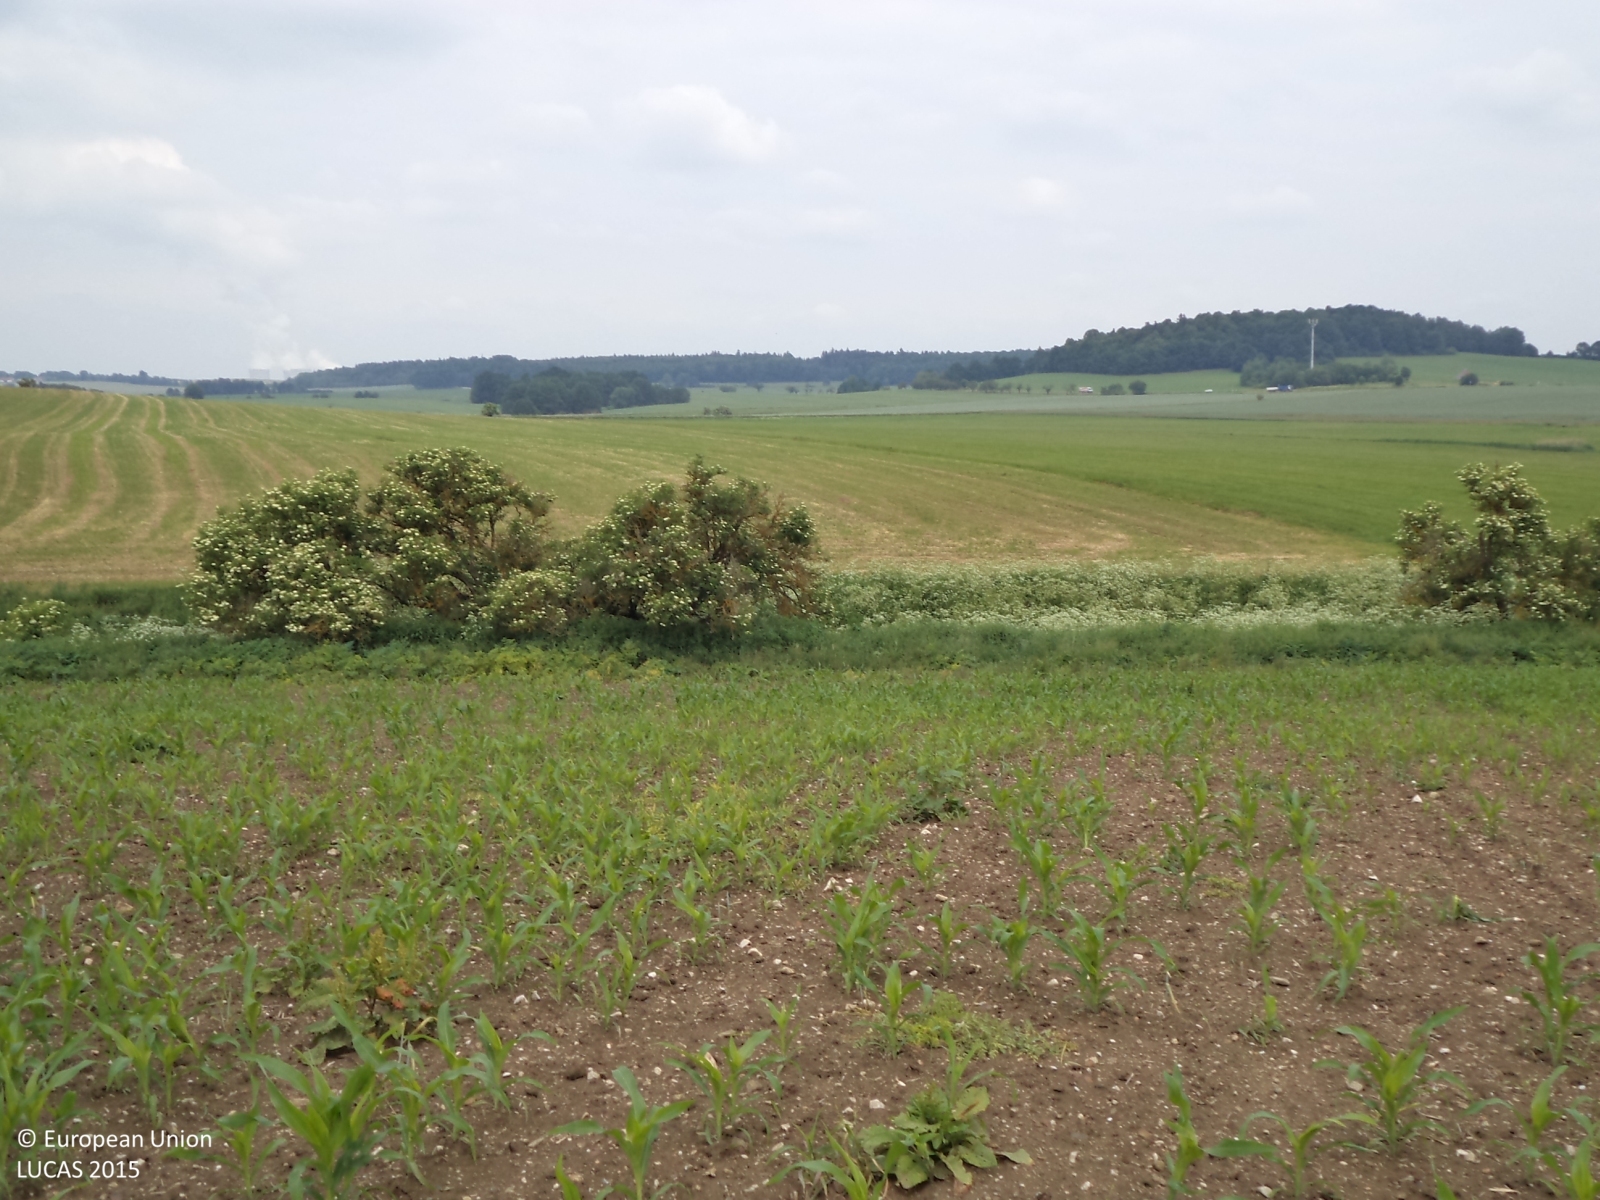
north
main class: Cropland
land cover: Maize
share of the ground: 25 - 50 %
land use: Agriculture (excluding fallow land and kitchen gardens)
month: June
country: CZ
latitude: 49.1088
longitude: 14.3984
